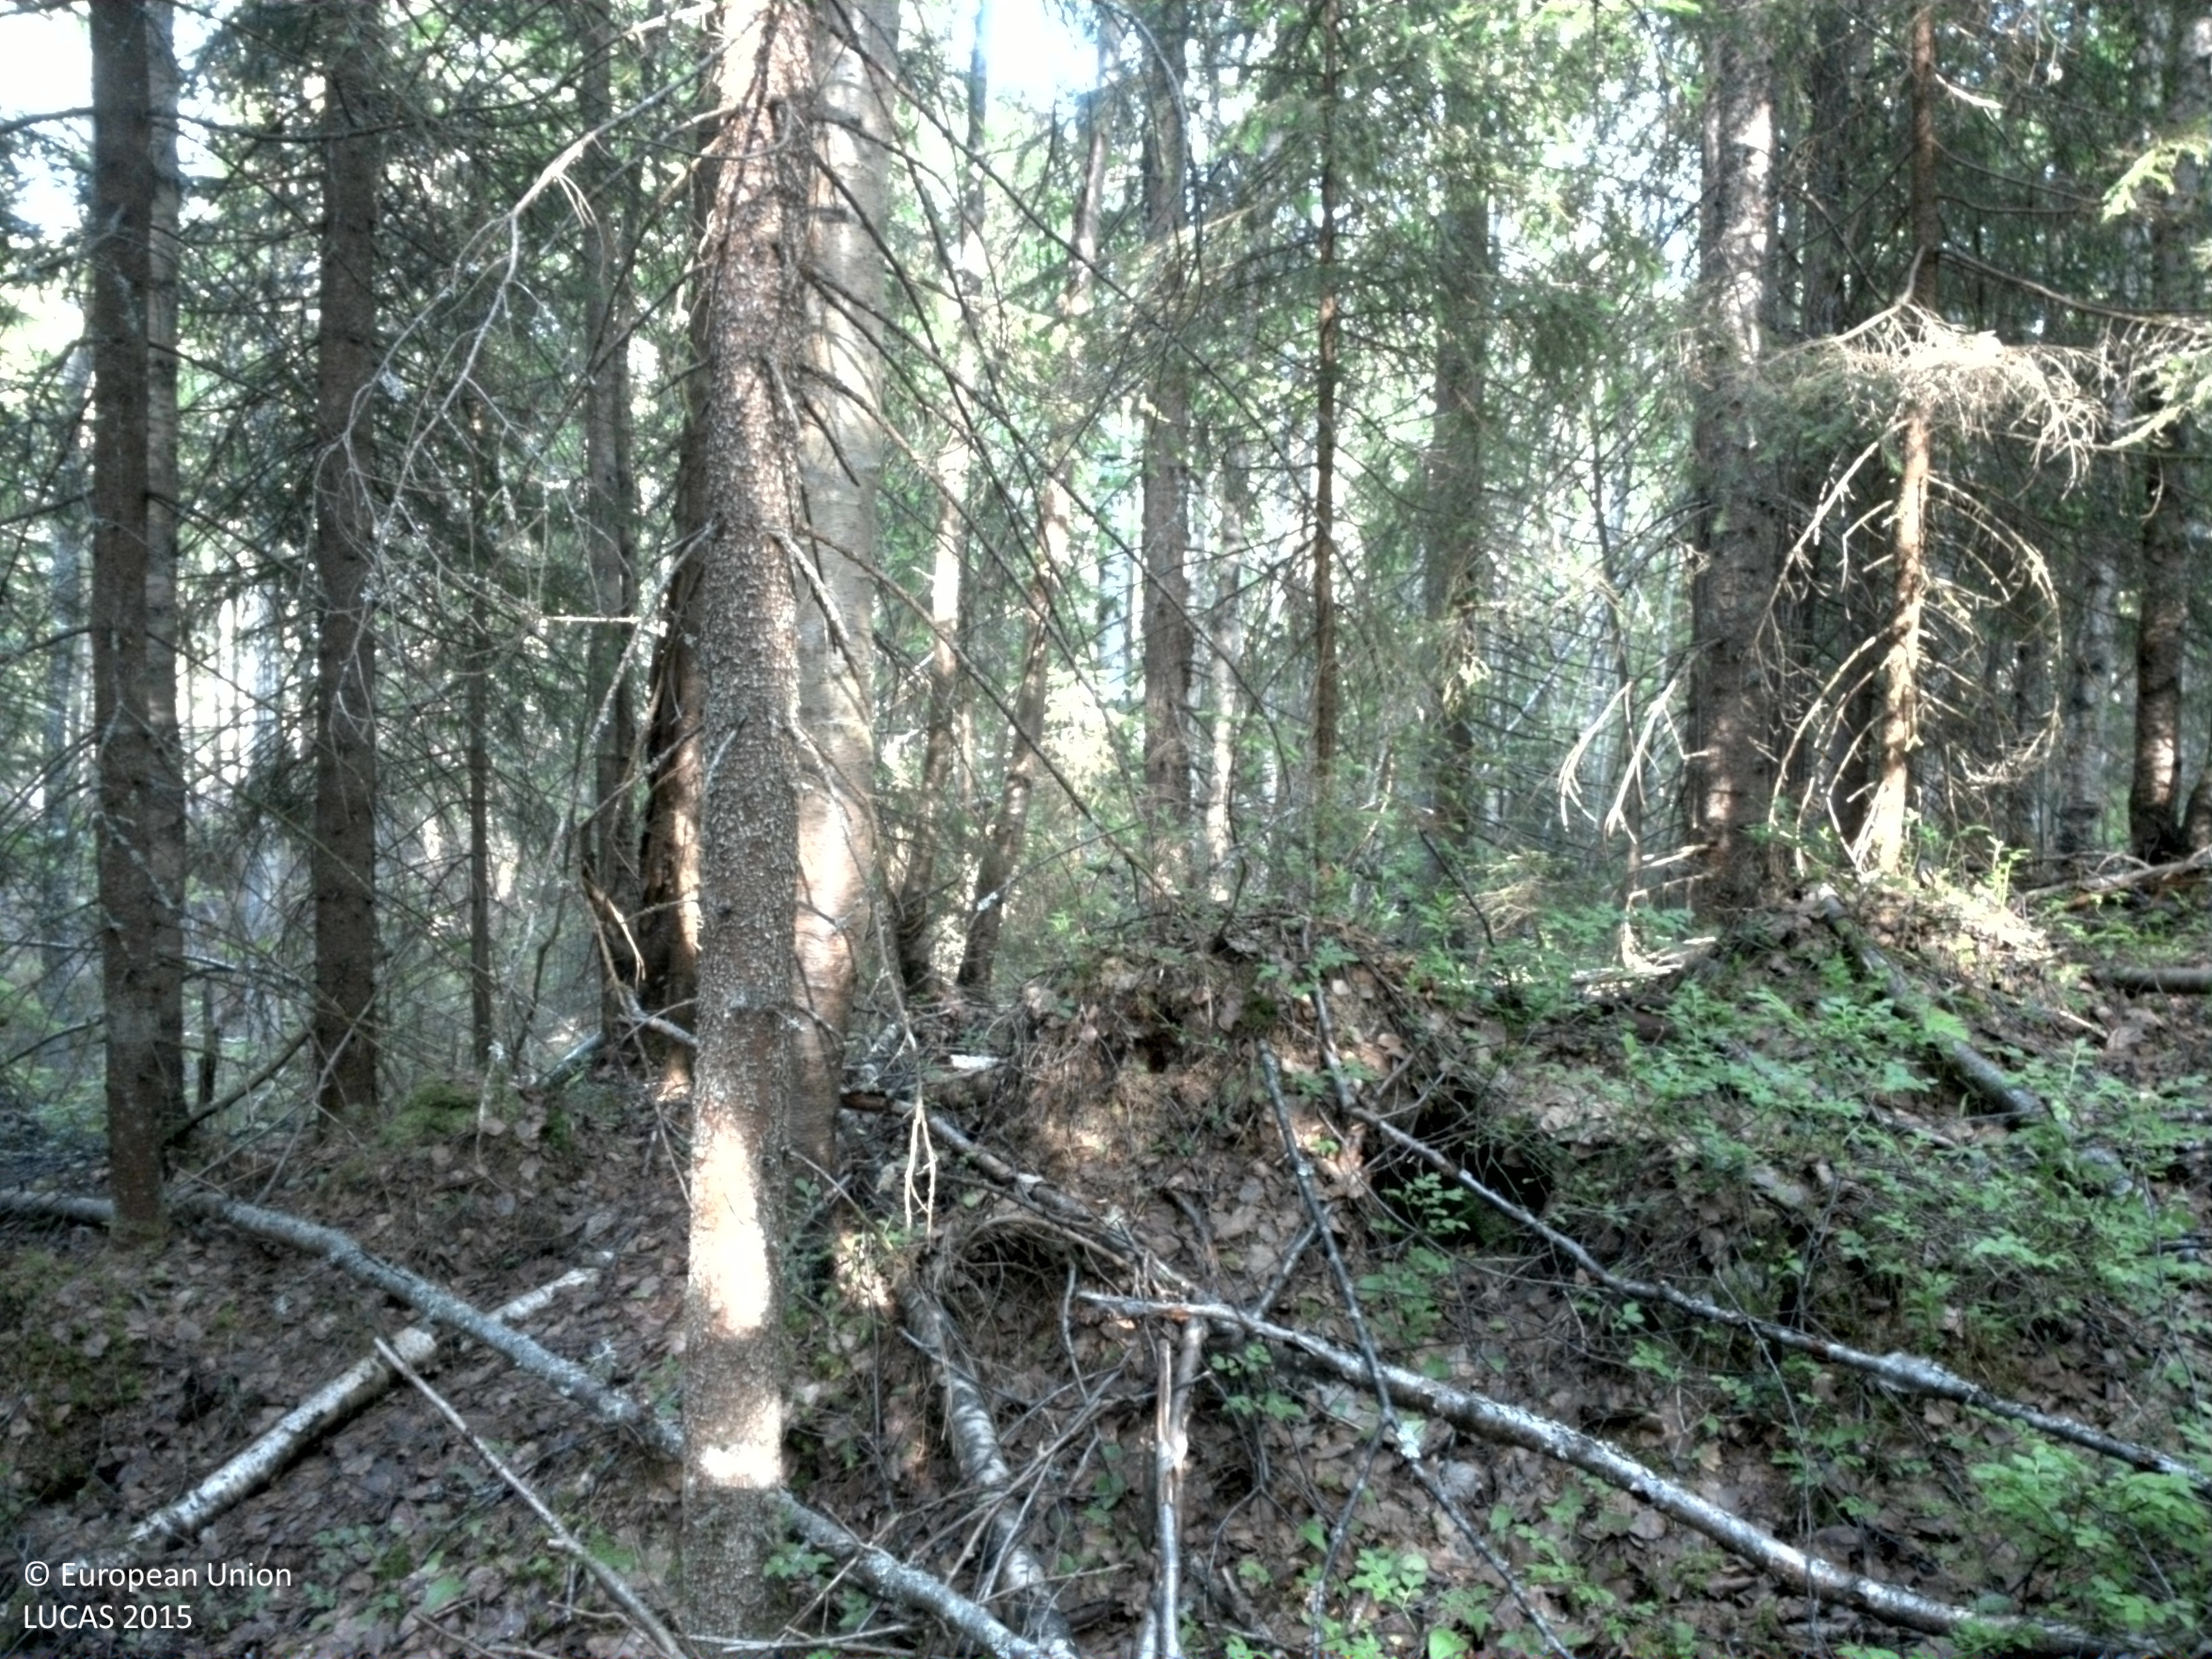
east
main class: Woodland
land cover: Spruce dominated mixed woodland
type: boreal forest
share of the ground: 50 - 75 %
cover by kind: coniferous forest trees 50 %, broadleaved forest trees 25 %, shrubs 25 %
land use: Forestry
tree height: > 5 m
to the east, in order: Spruce dominated mixed woodland; Ditches and canals; Spruce dominated mixed woodland; Other coniferous woodland; Other bare soil; Other coniferous woodland; Ditches and canals; Grass margins; Paved roads, cycling and walking lanes; Grass margins; Spruce dominated coniferous woodland; Other mixed woodland; Broadleaved woodland
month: July
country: SE
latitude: 64.3060
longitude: 20.7510
